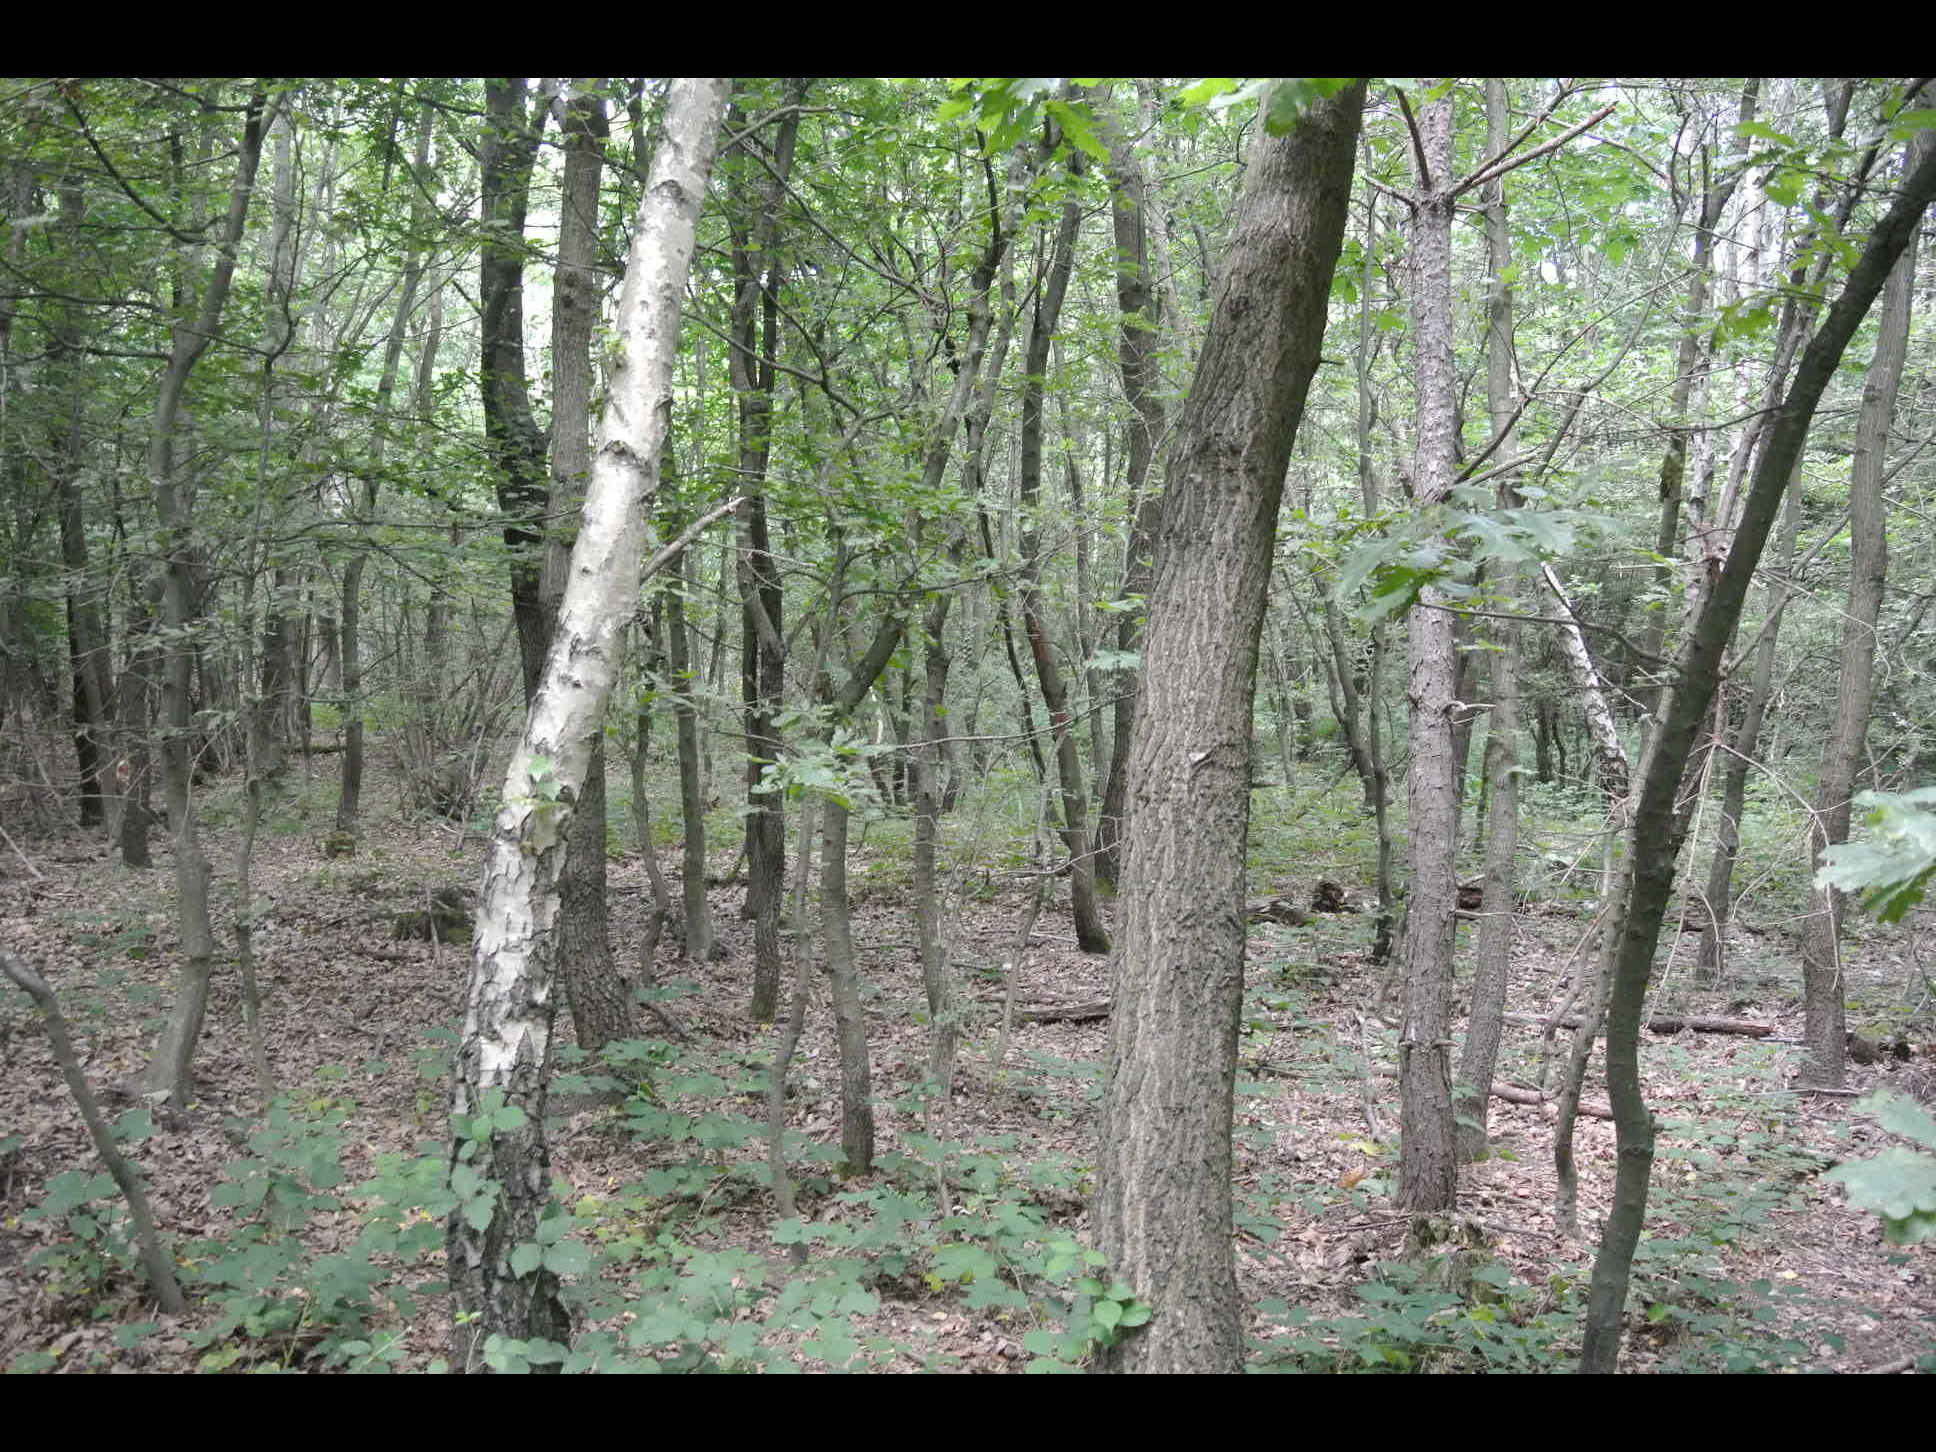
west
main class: Woodland
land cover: Broadleaved woodland
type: beech forest
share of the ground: > 75 %
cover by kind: broadleaved forest trees 100 %
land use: Forestry
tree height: > 5 m
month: July
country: AT
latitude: 47.7265
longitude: 16.4705
